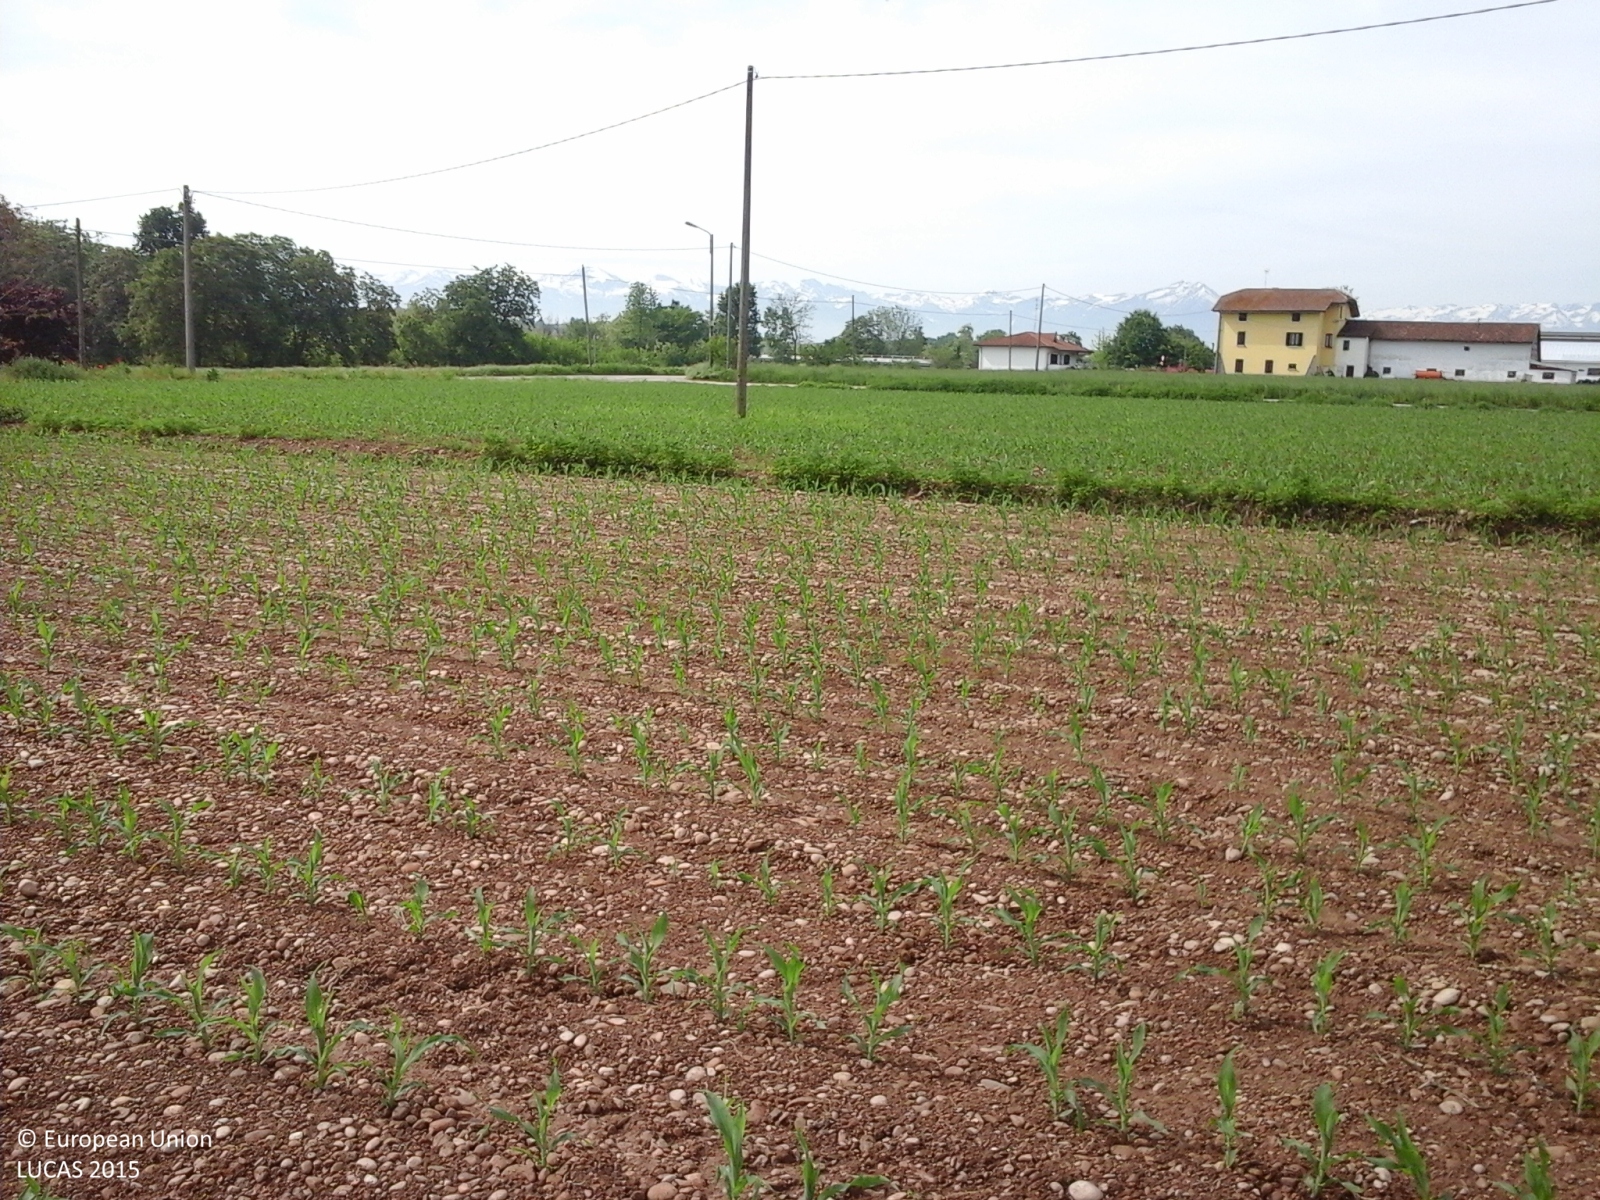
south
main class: Cropland
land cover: Maize
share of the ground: 25 - 50 %
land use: Agriculture (excluding fallow land and kitchen gardens)
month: May
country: IT
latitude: 44.5427
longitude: 7.7517
